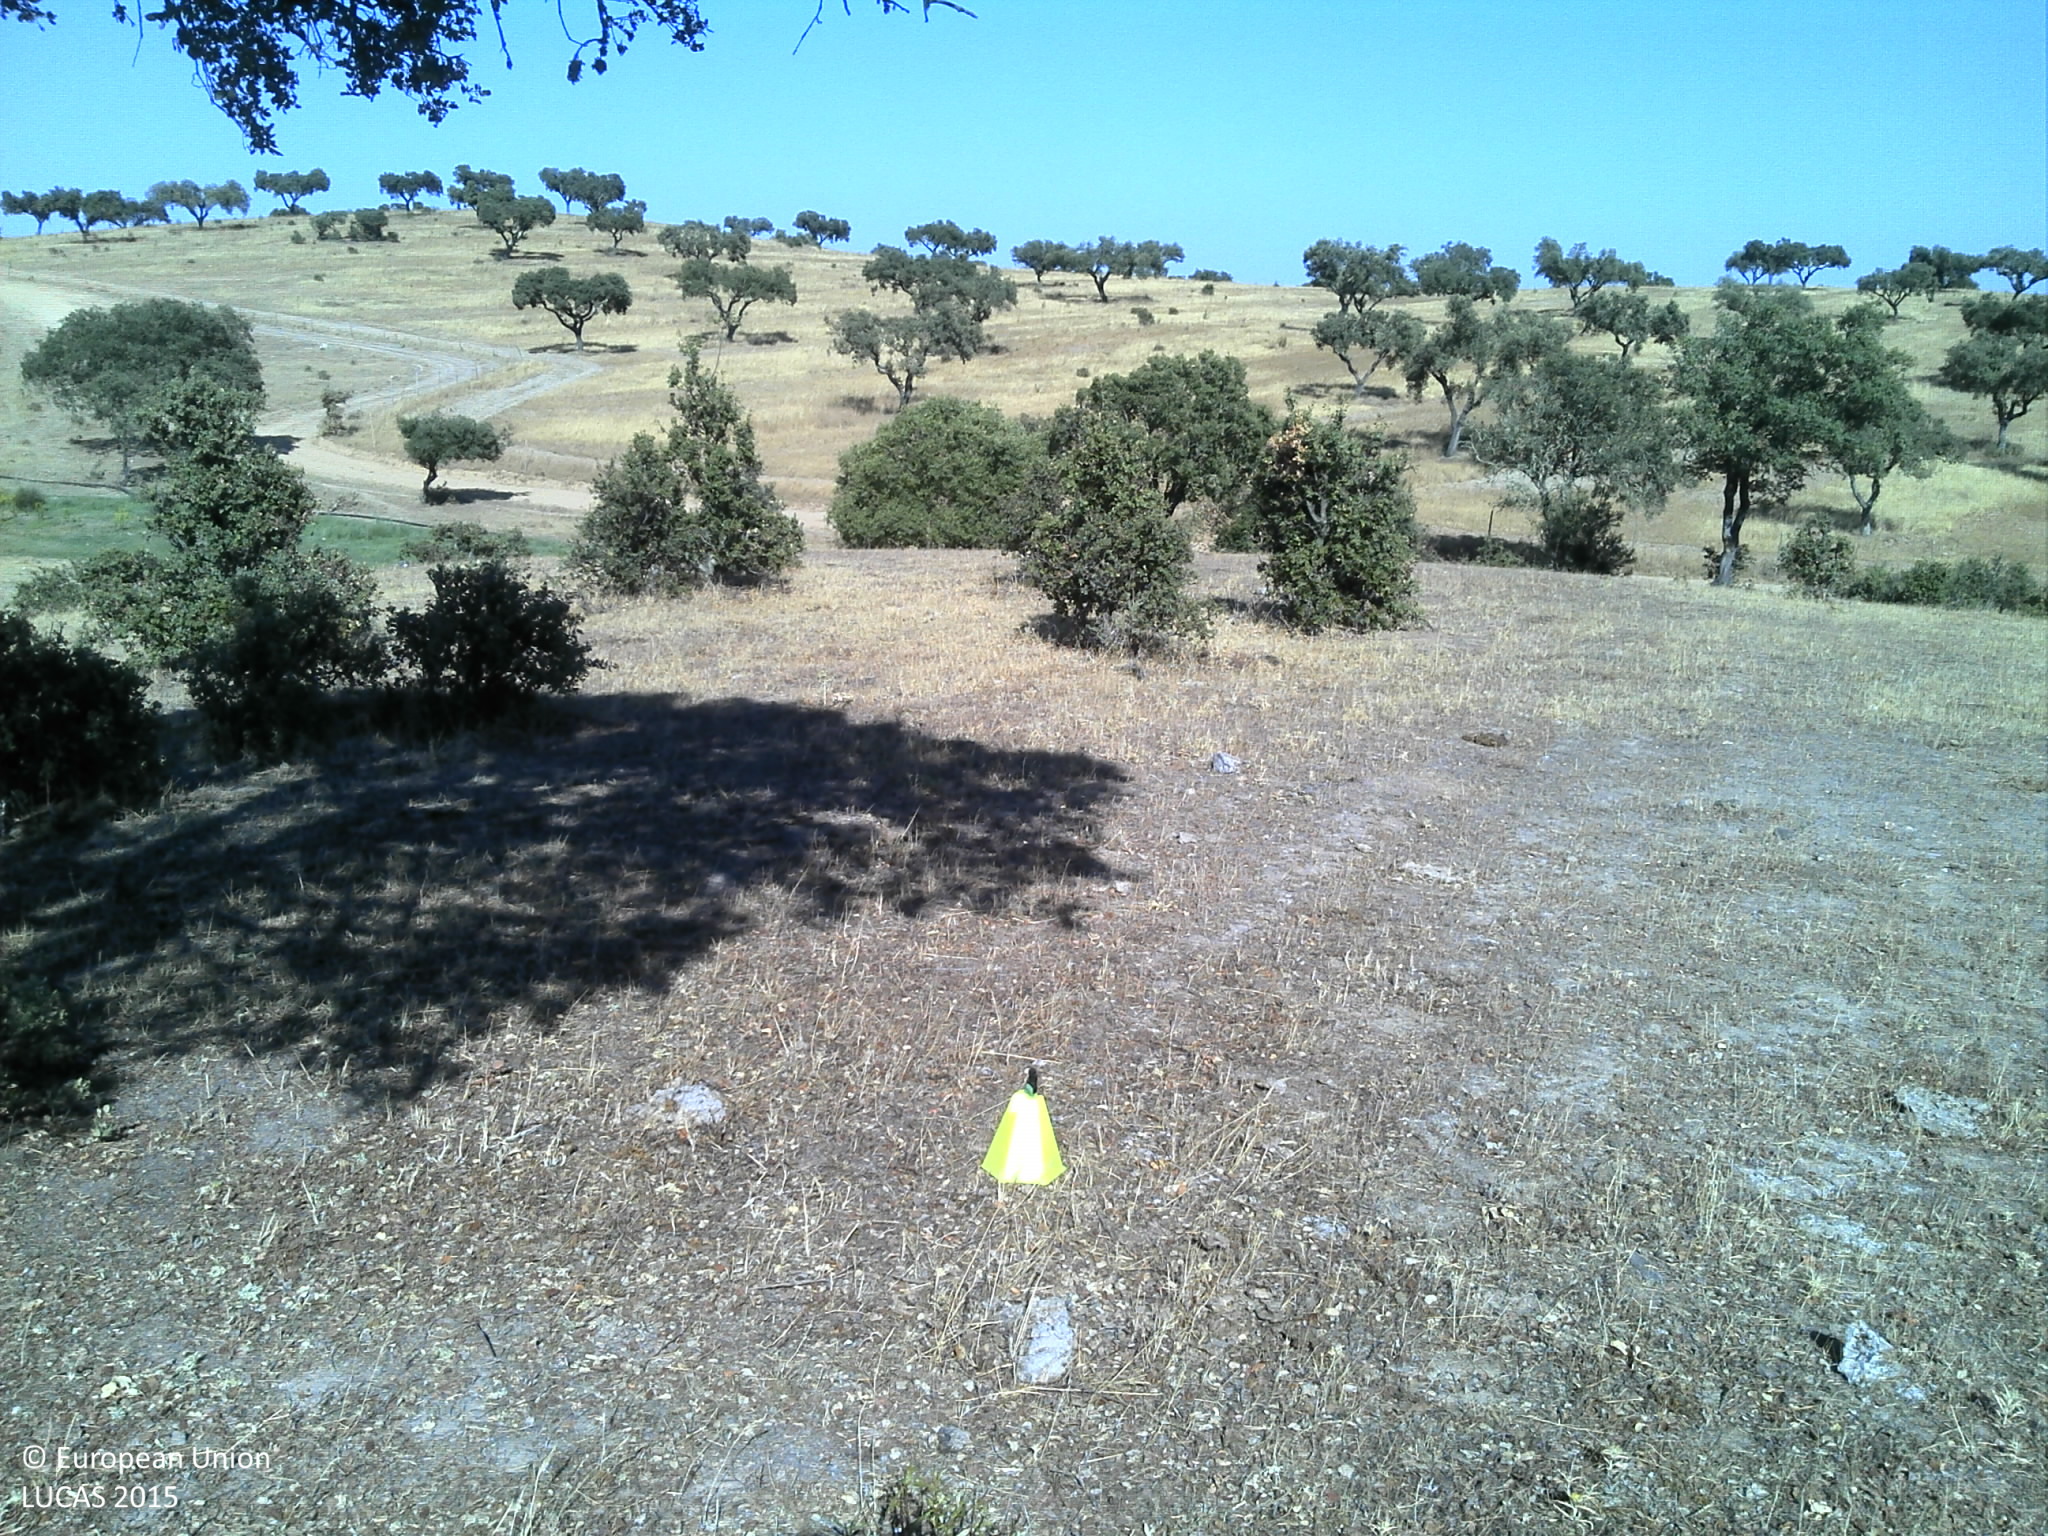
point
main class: Grassland
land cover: Grassland with sparse tree/shrub cover
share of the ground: 10 - 25 %
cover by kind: unconsolidated bare surface 70 %, herbaceous plants 25 %, broadleaved forest trees 5 %
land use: Agriculture (excluding fallow land and kitchen gardens)
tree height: < 5 m
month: July
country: PT
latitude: 38.5058
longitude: -7.4463
